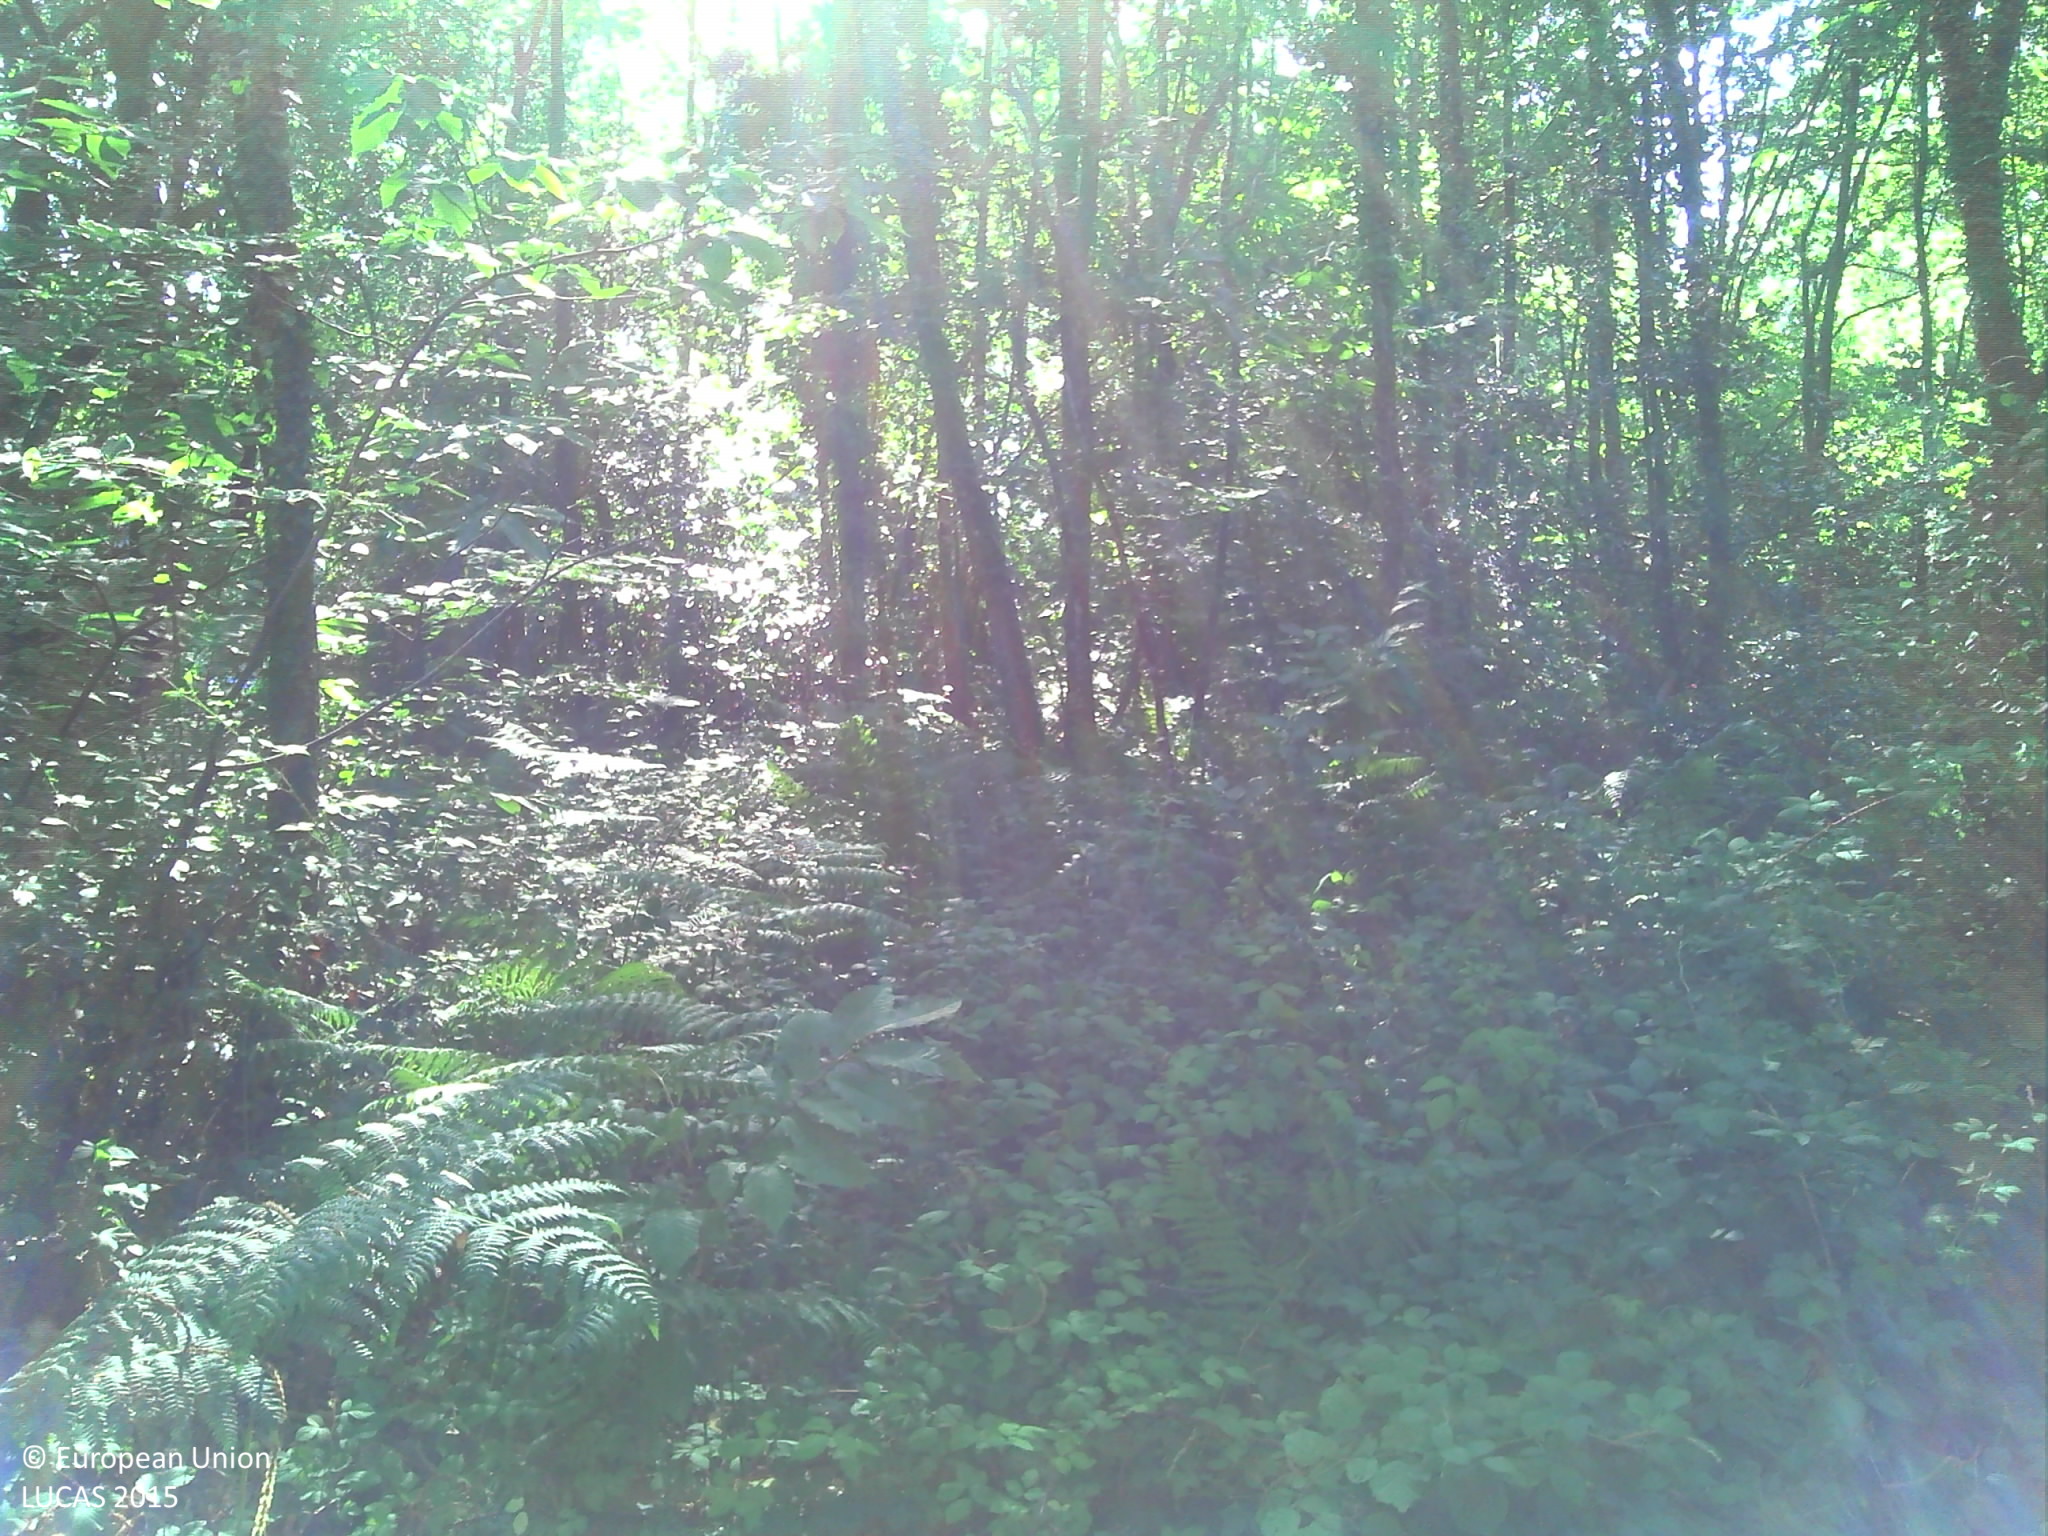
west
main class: Woodland
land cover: Broadleaved woodland
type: mesophytic deciduous forest
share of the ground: > 75 %
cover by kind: broadleaved forest trees 80 %, shrubs 10 %, herbaceous plants 10 %
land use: Forestry
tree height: > 5 m
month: July
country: FR
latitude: 47.7847
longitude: -3.2447
